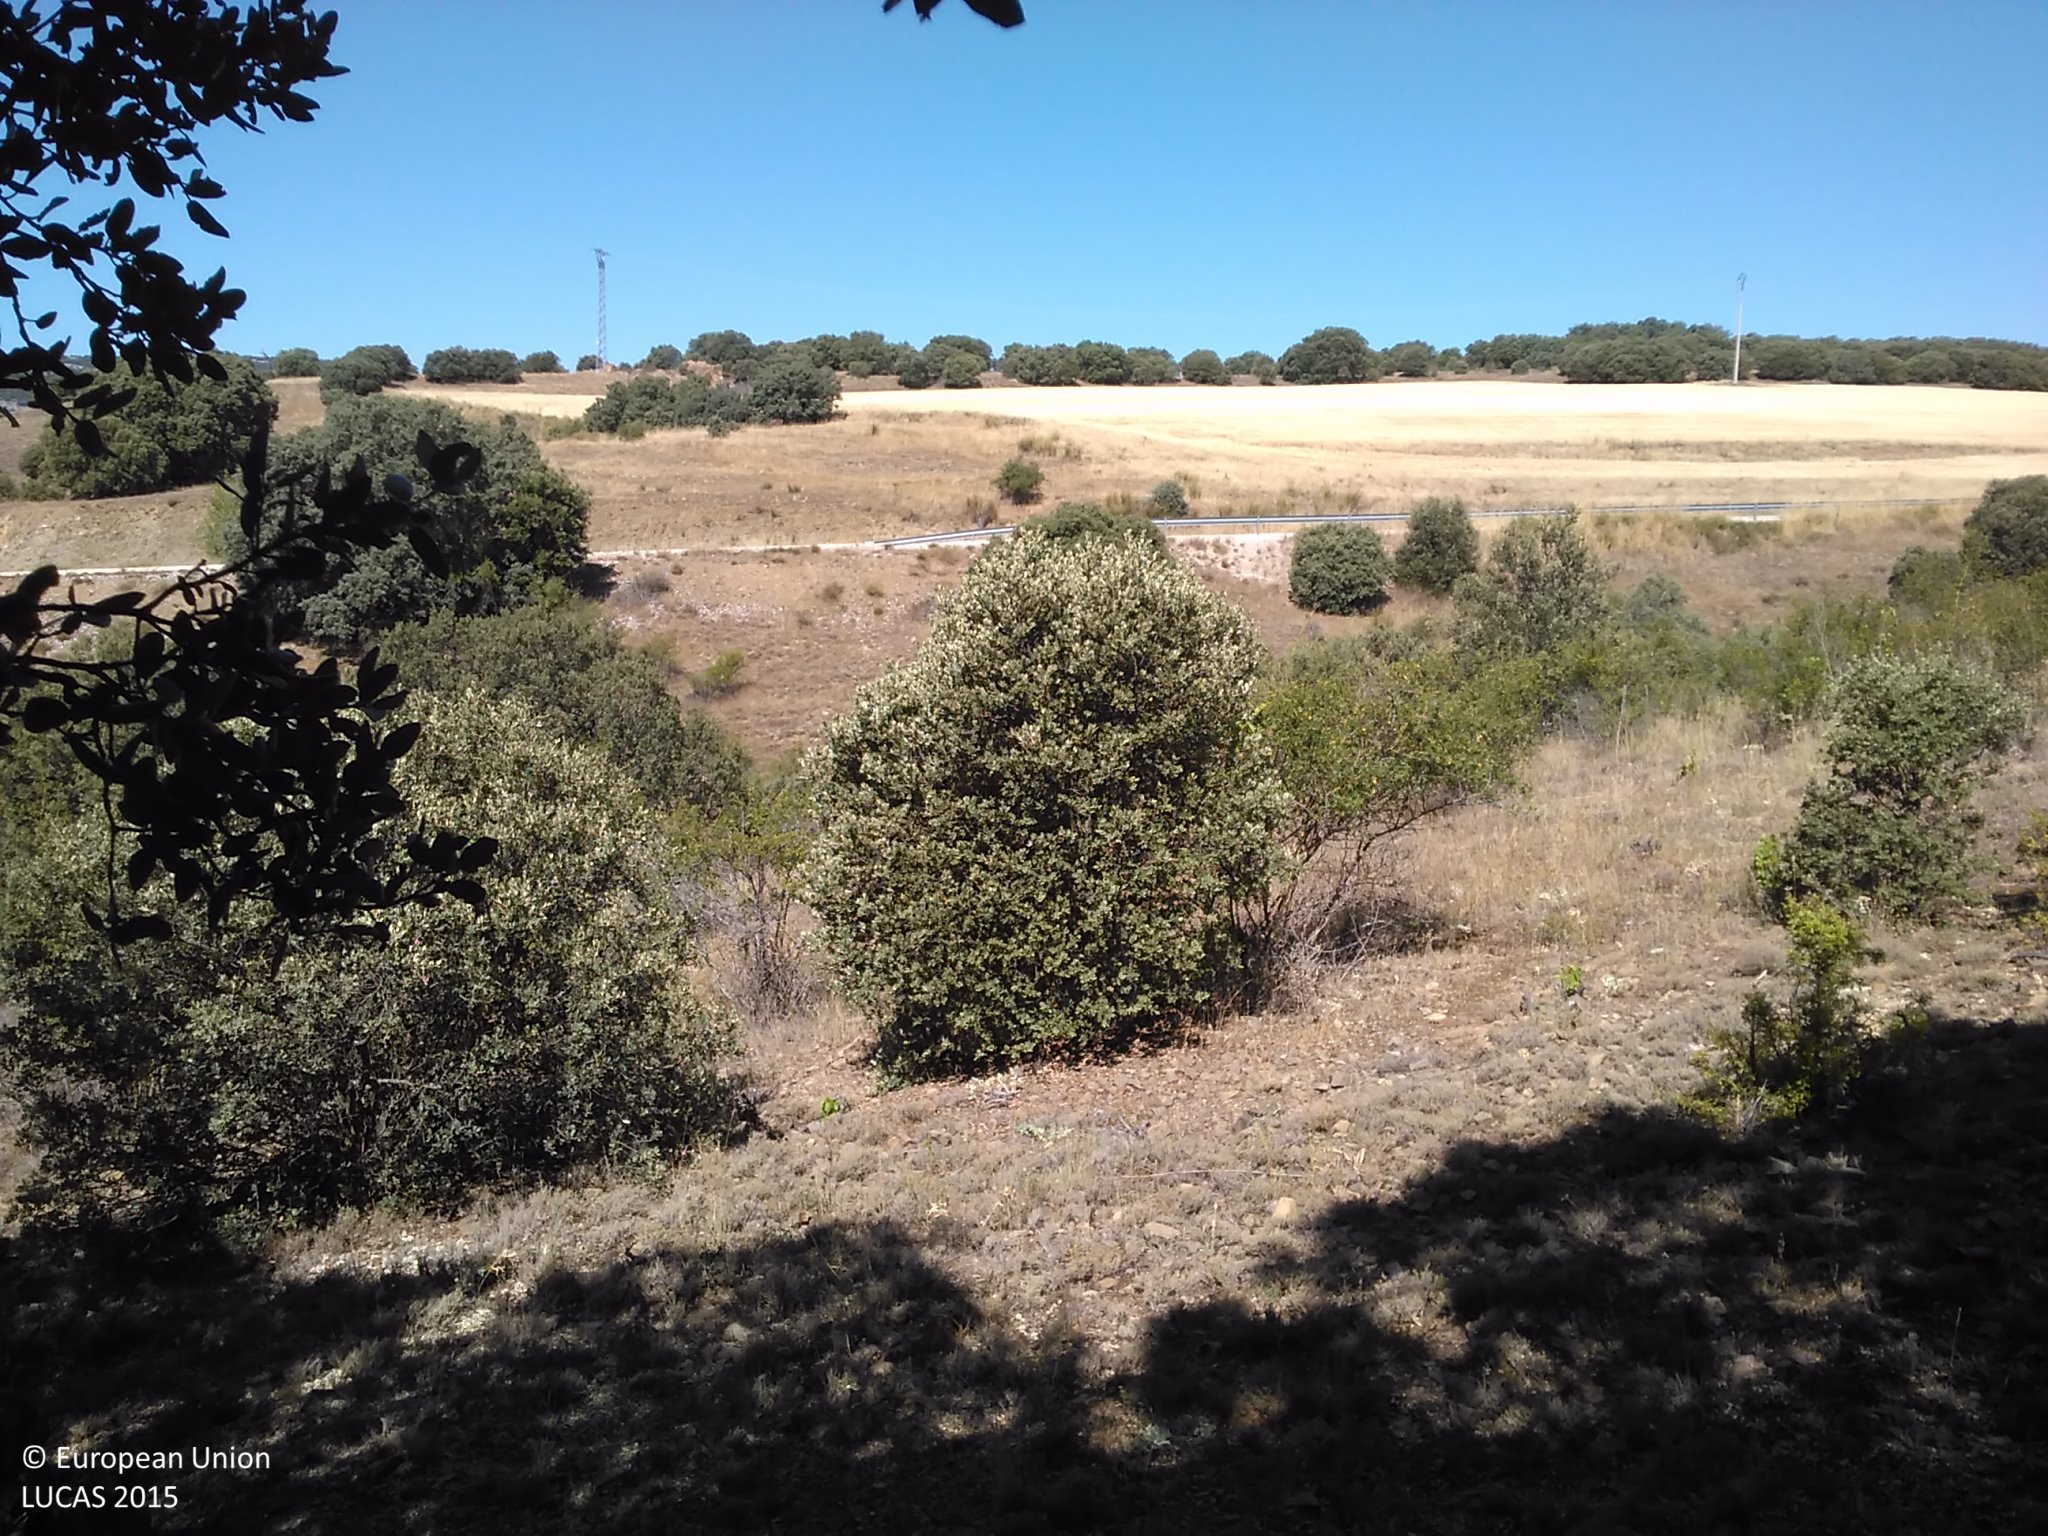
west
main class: Woodland
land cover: Broadleaved woodland
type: broadleaved evergreen forest
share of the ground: 50 - 75 %
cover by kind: broadleaved forest trees 70 %, shrubs 10 %, herbaceous plants 10 %, unconsolidated bare surface 10 %
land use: Semi-natural and natural areas not in use
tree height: > 5 m
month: July
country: ES
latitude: 41.5359
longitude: -2.0047
